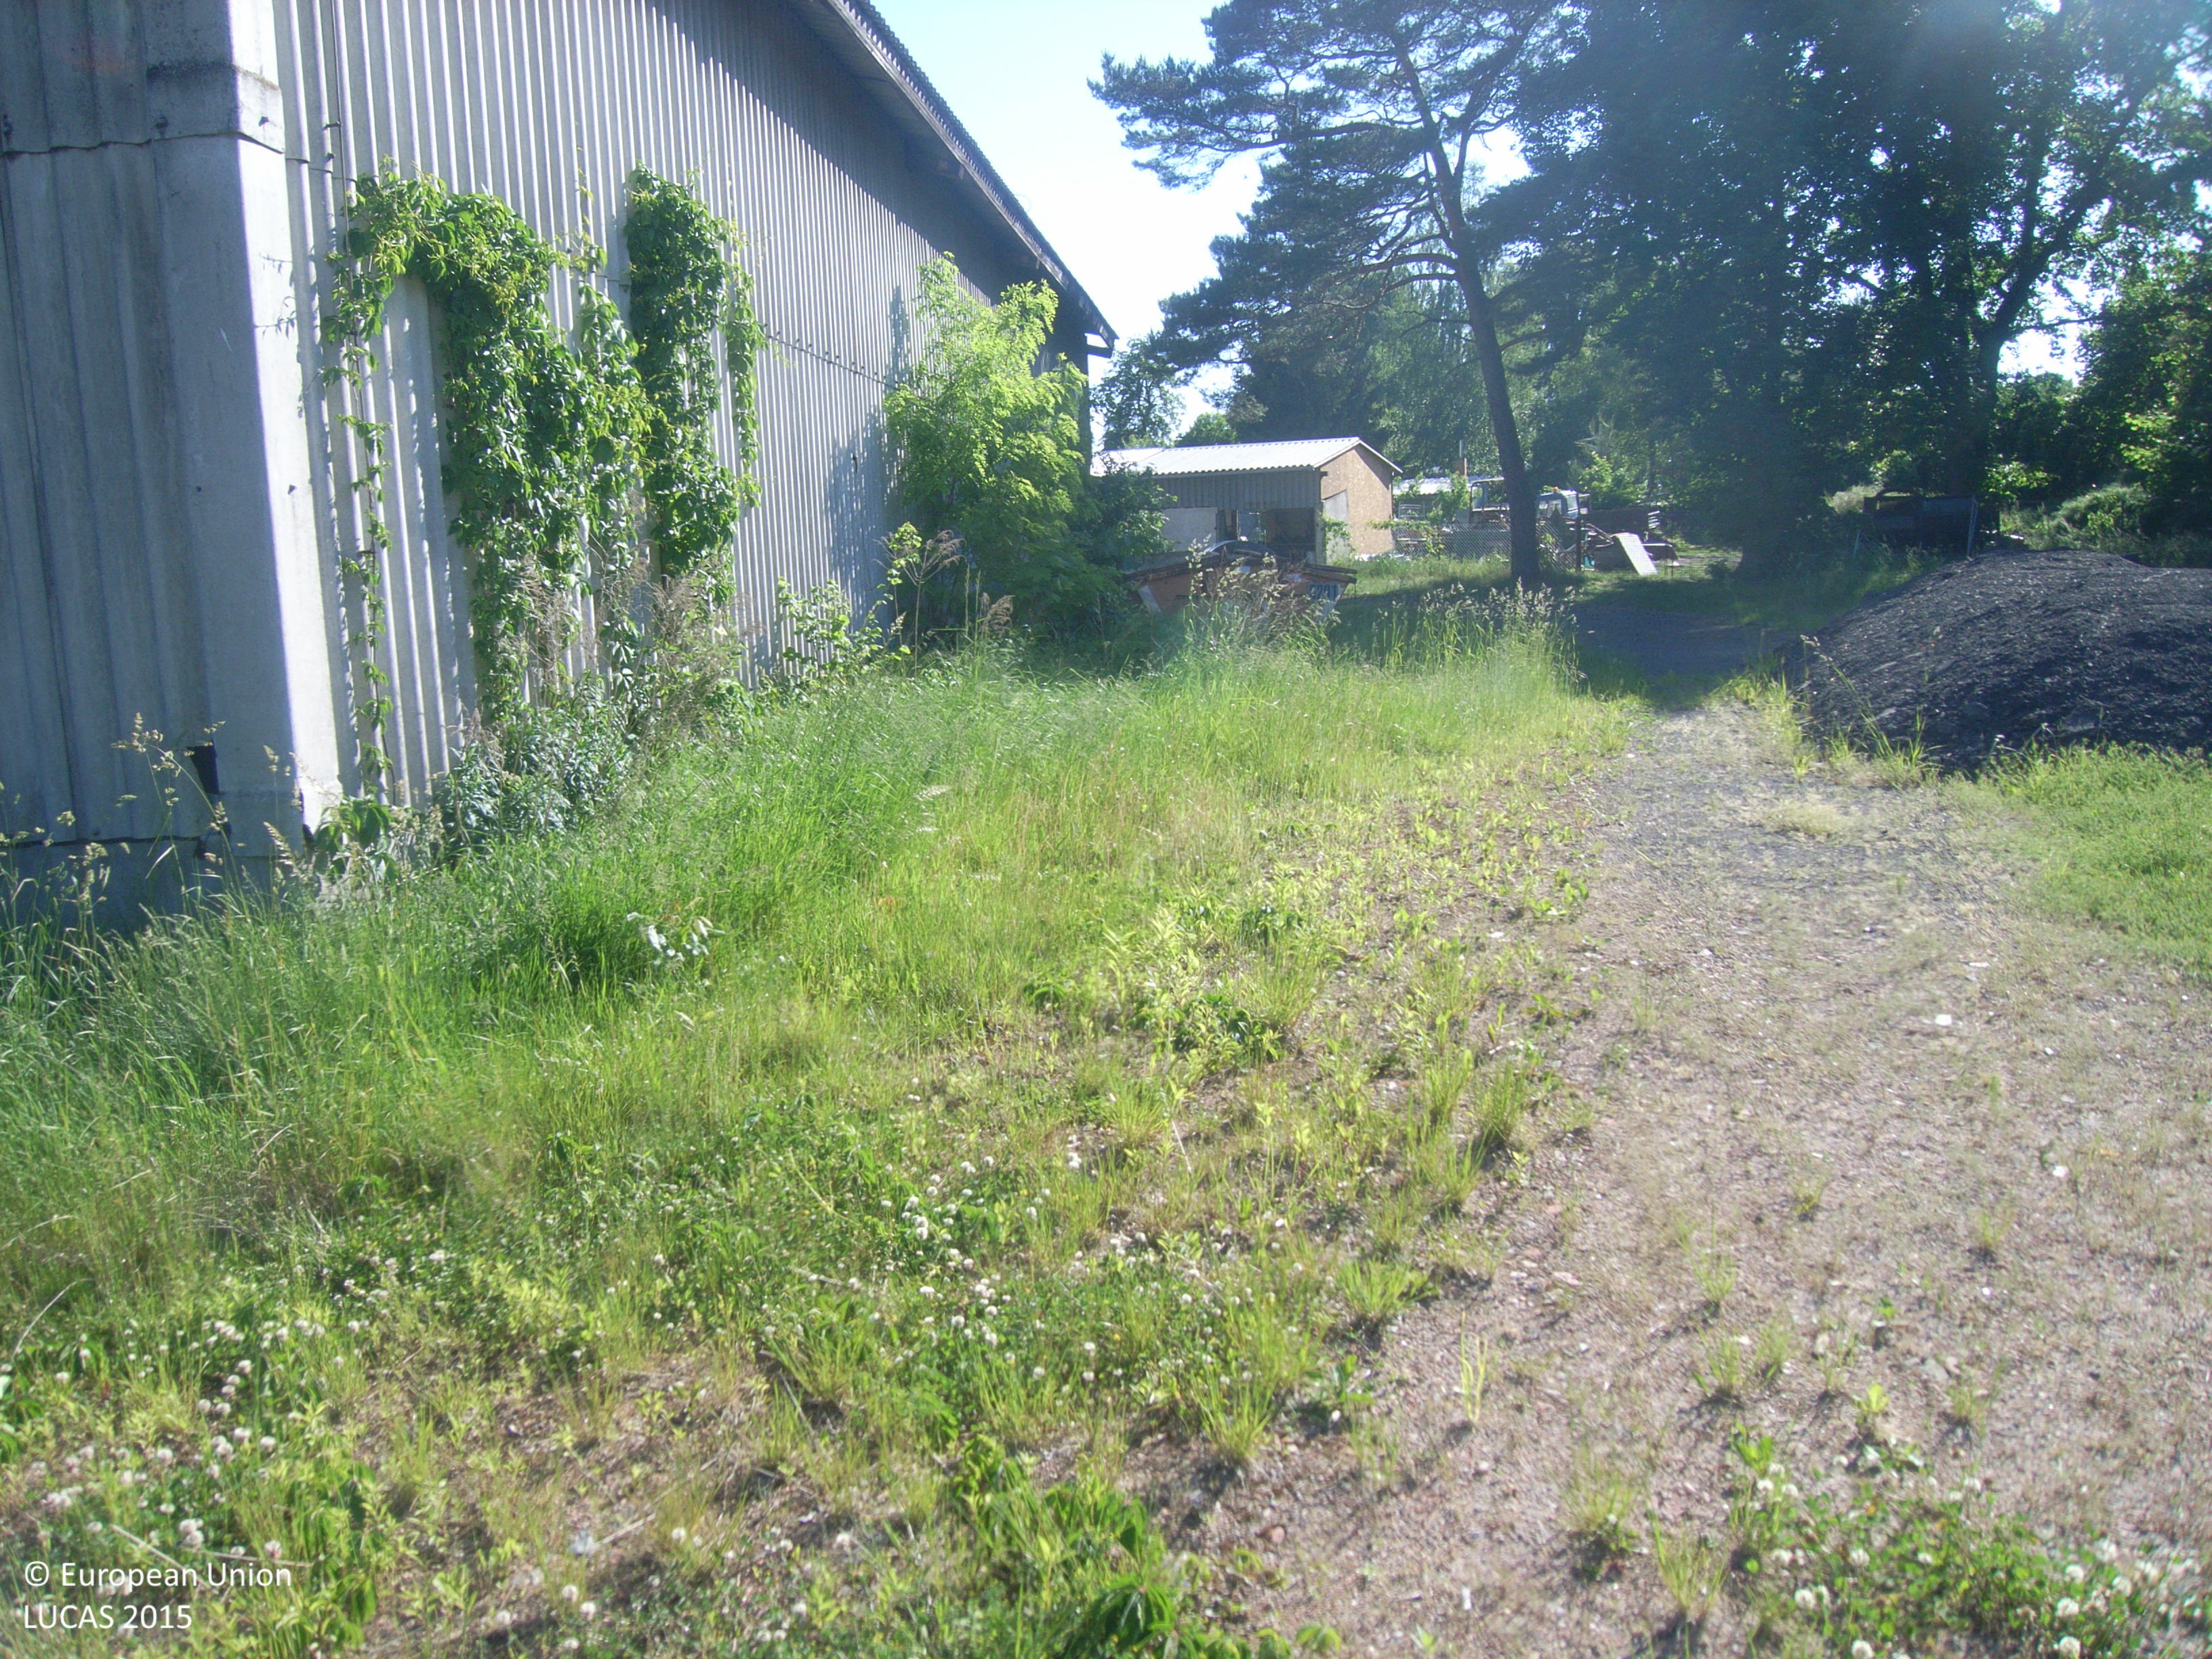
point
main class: Grassland
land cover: Grassland without tree/shrub cover
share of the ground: > 75 %
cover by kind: herbaceous plants 100 %
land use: Construction
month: June
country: DE
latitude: 52.2416
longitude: 14.4096
